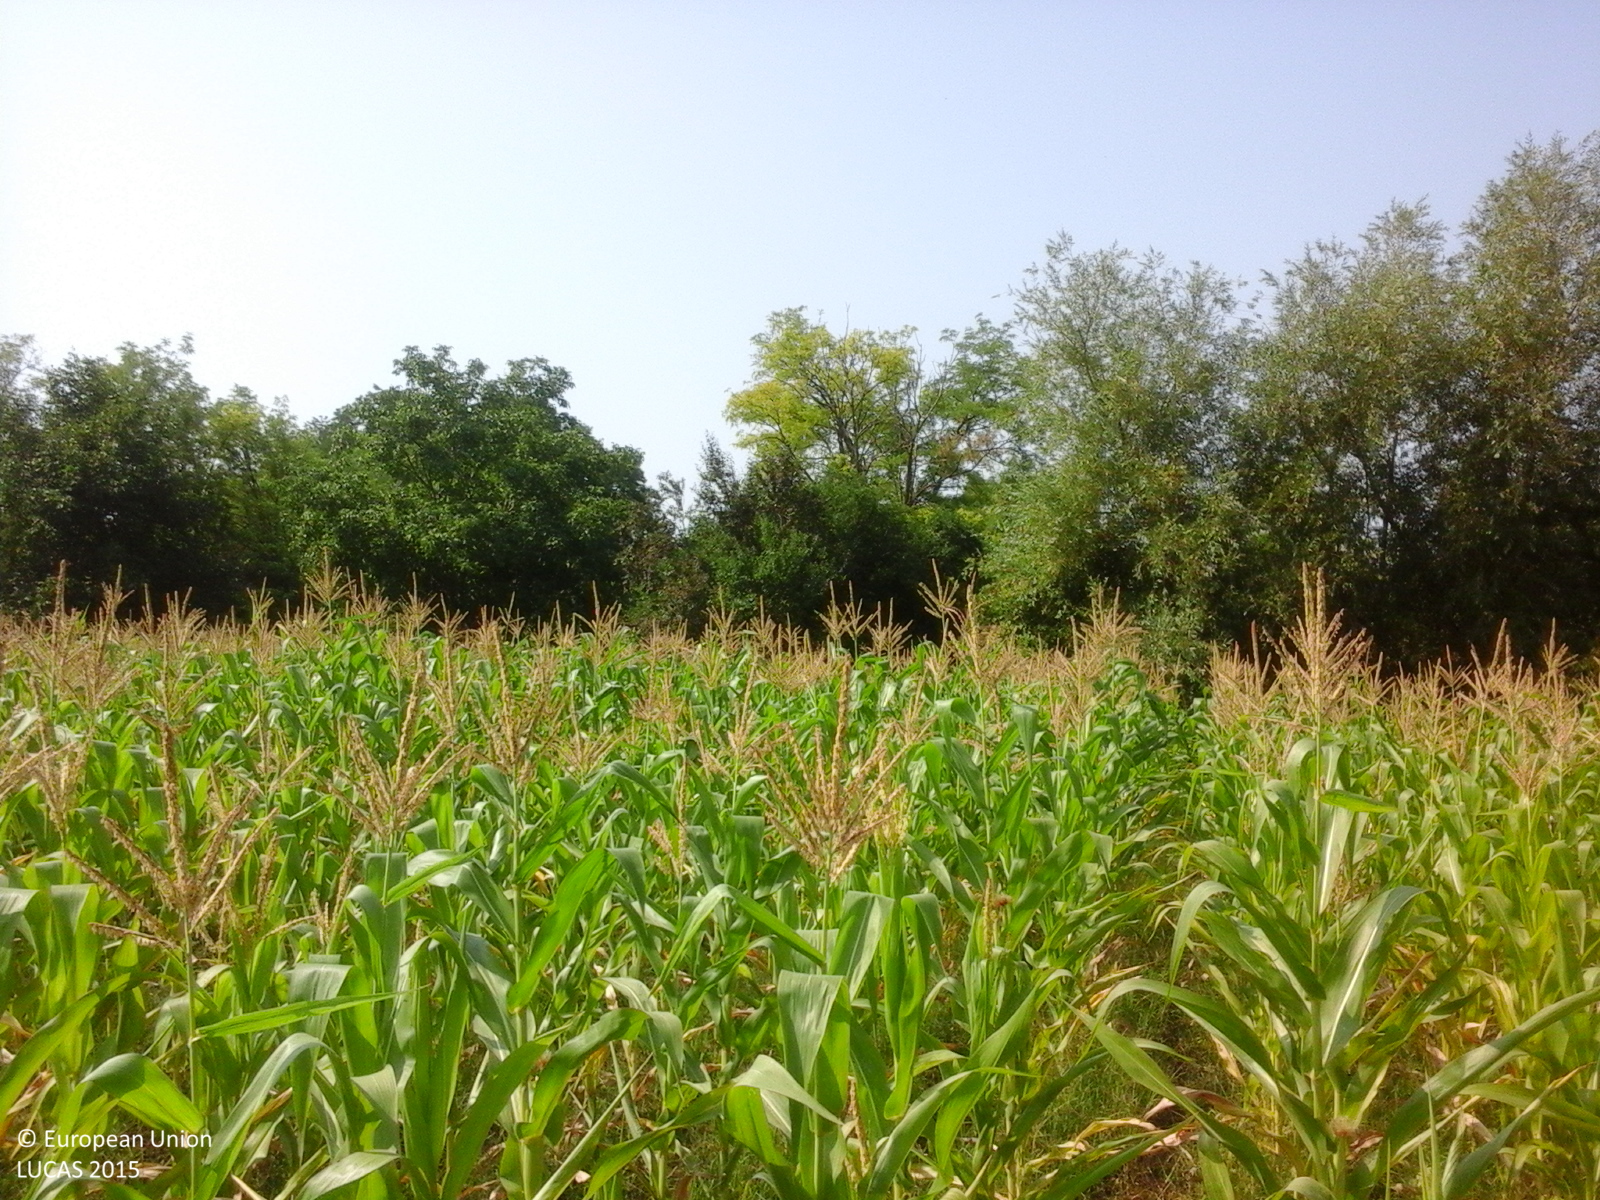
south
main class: Cropland
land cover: Maize
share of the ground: > 75 %
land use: Agriculture (excluding fallow land and kitchen gardens)
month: July
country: RO
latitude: 44.6522
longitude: 26.6268
